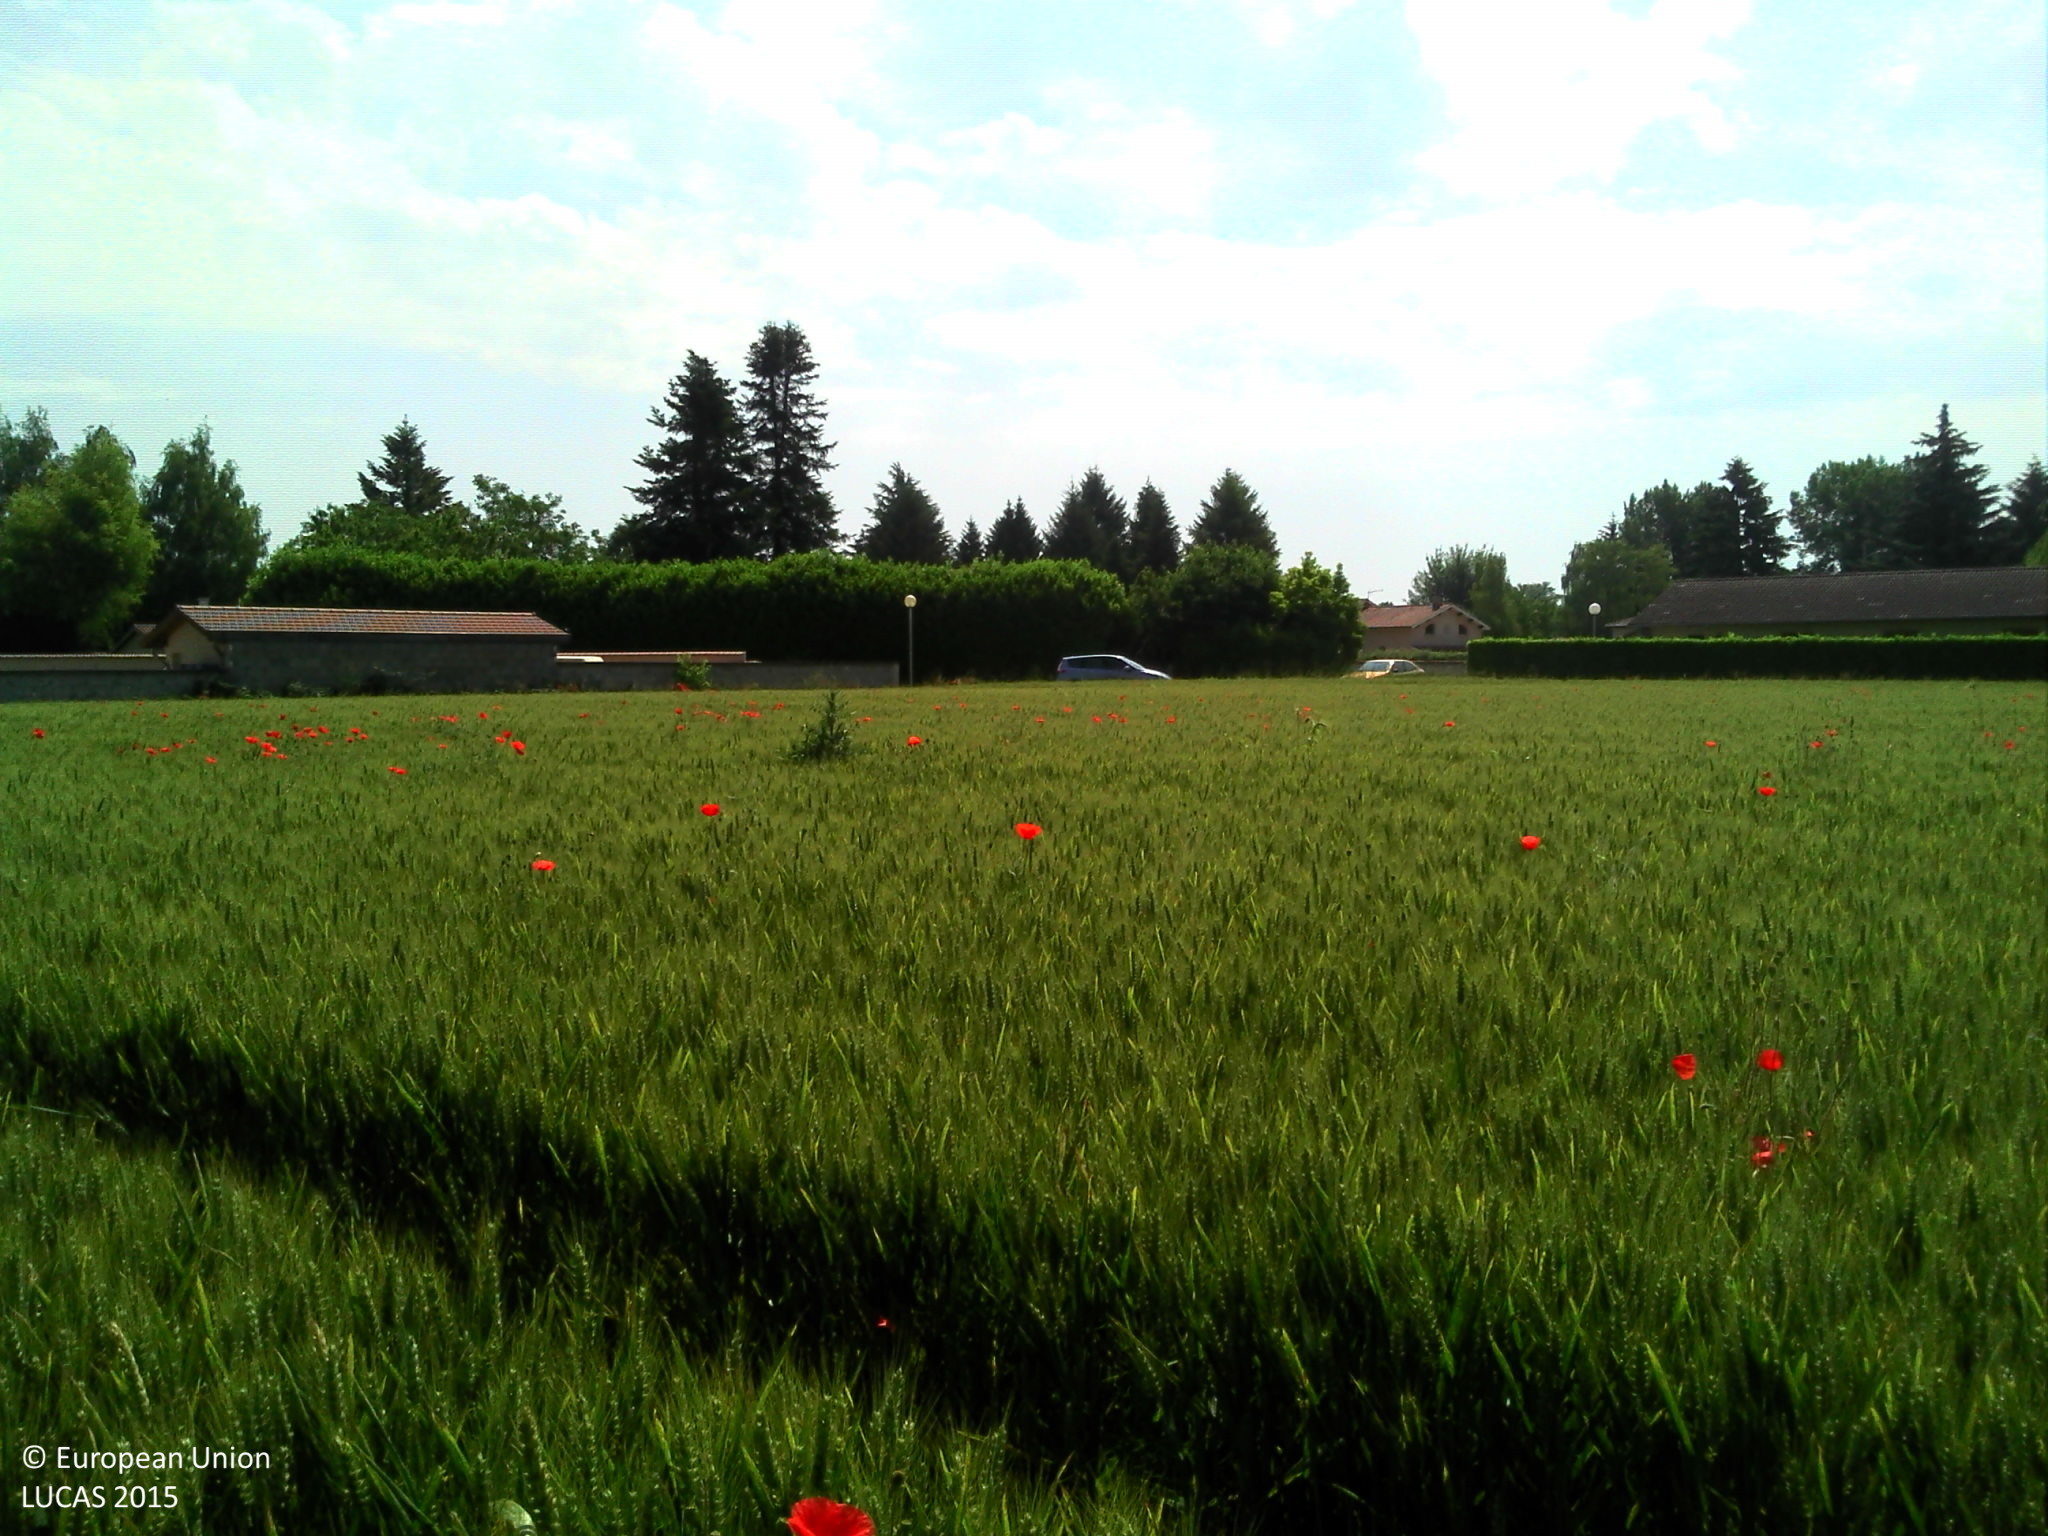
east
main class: Cropland
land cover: Durum wheat
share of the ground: > 75 %
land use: Agriculture (excluding fallow land and kitchen gardens)
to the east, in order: Durum wheat; Artificial constructions in urban areas; Broadleaved woodland; Grassland with sparse tree/shrub cover; Artificial constructions in urban areas
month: June
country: FR
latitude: 45.8094
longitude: 5.1782
